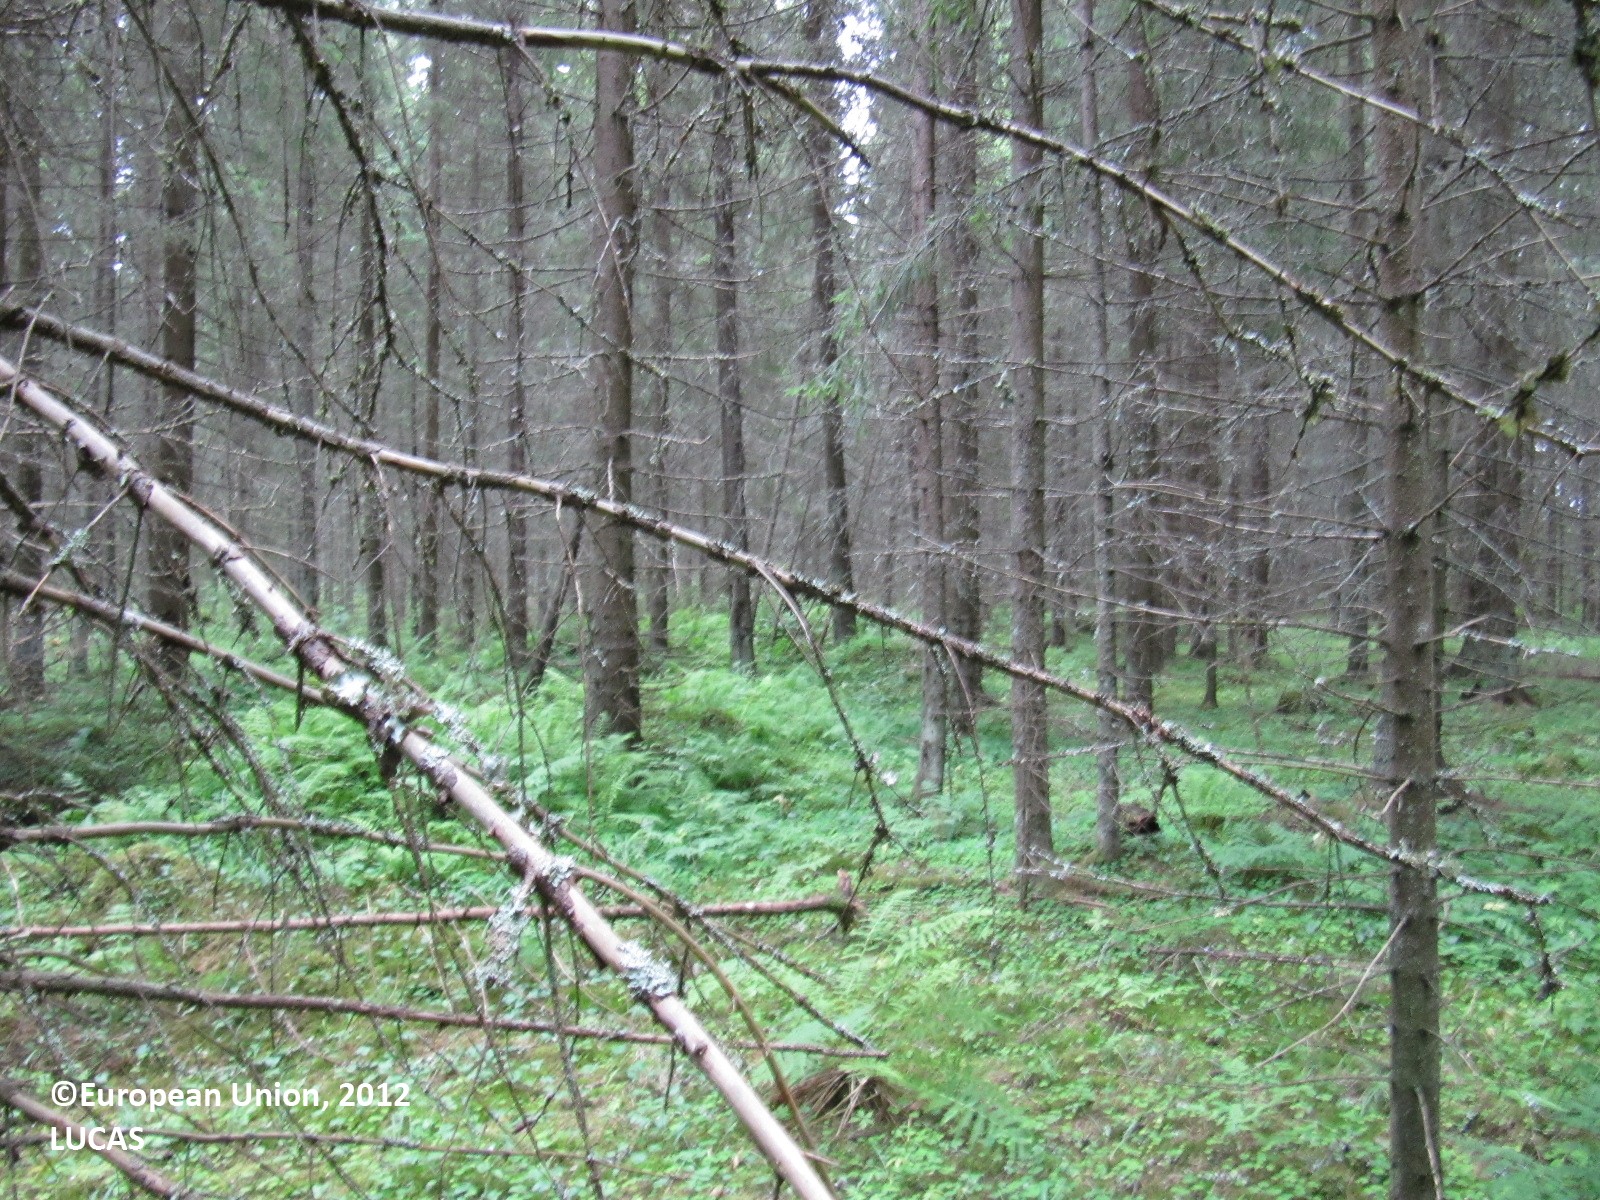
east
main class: Woodland
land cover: Spruce dominated coniferous woodland
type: boreal forest
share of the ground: > 75 %
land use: Forestry
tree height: > 5 m
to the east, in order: Spruce dominated coniferous woodland; Rivers and streams; Spruce dominated coniferous woodland; Paved roads, cycling and walking lanes; Electric lines; Spontaneously vegetated surfaces; Ditches and canals; Spruce dominated mixed woodland
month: July
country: FI
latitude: 60.9889
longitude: 24.6531
